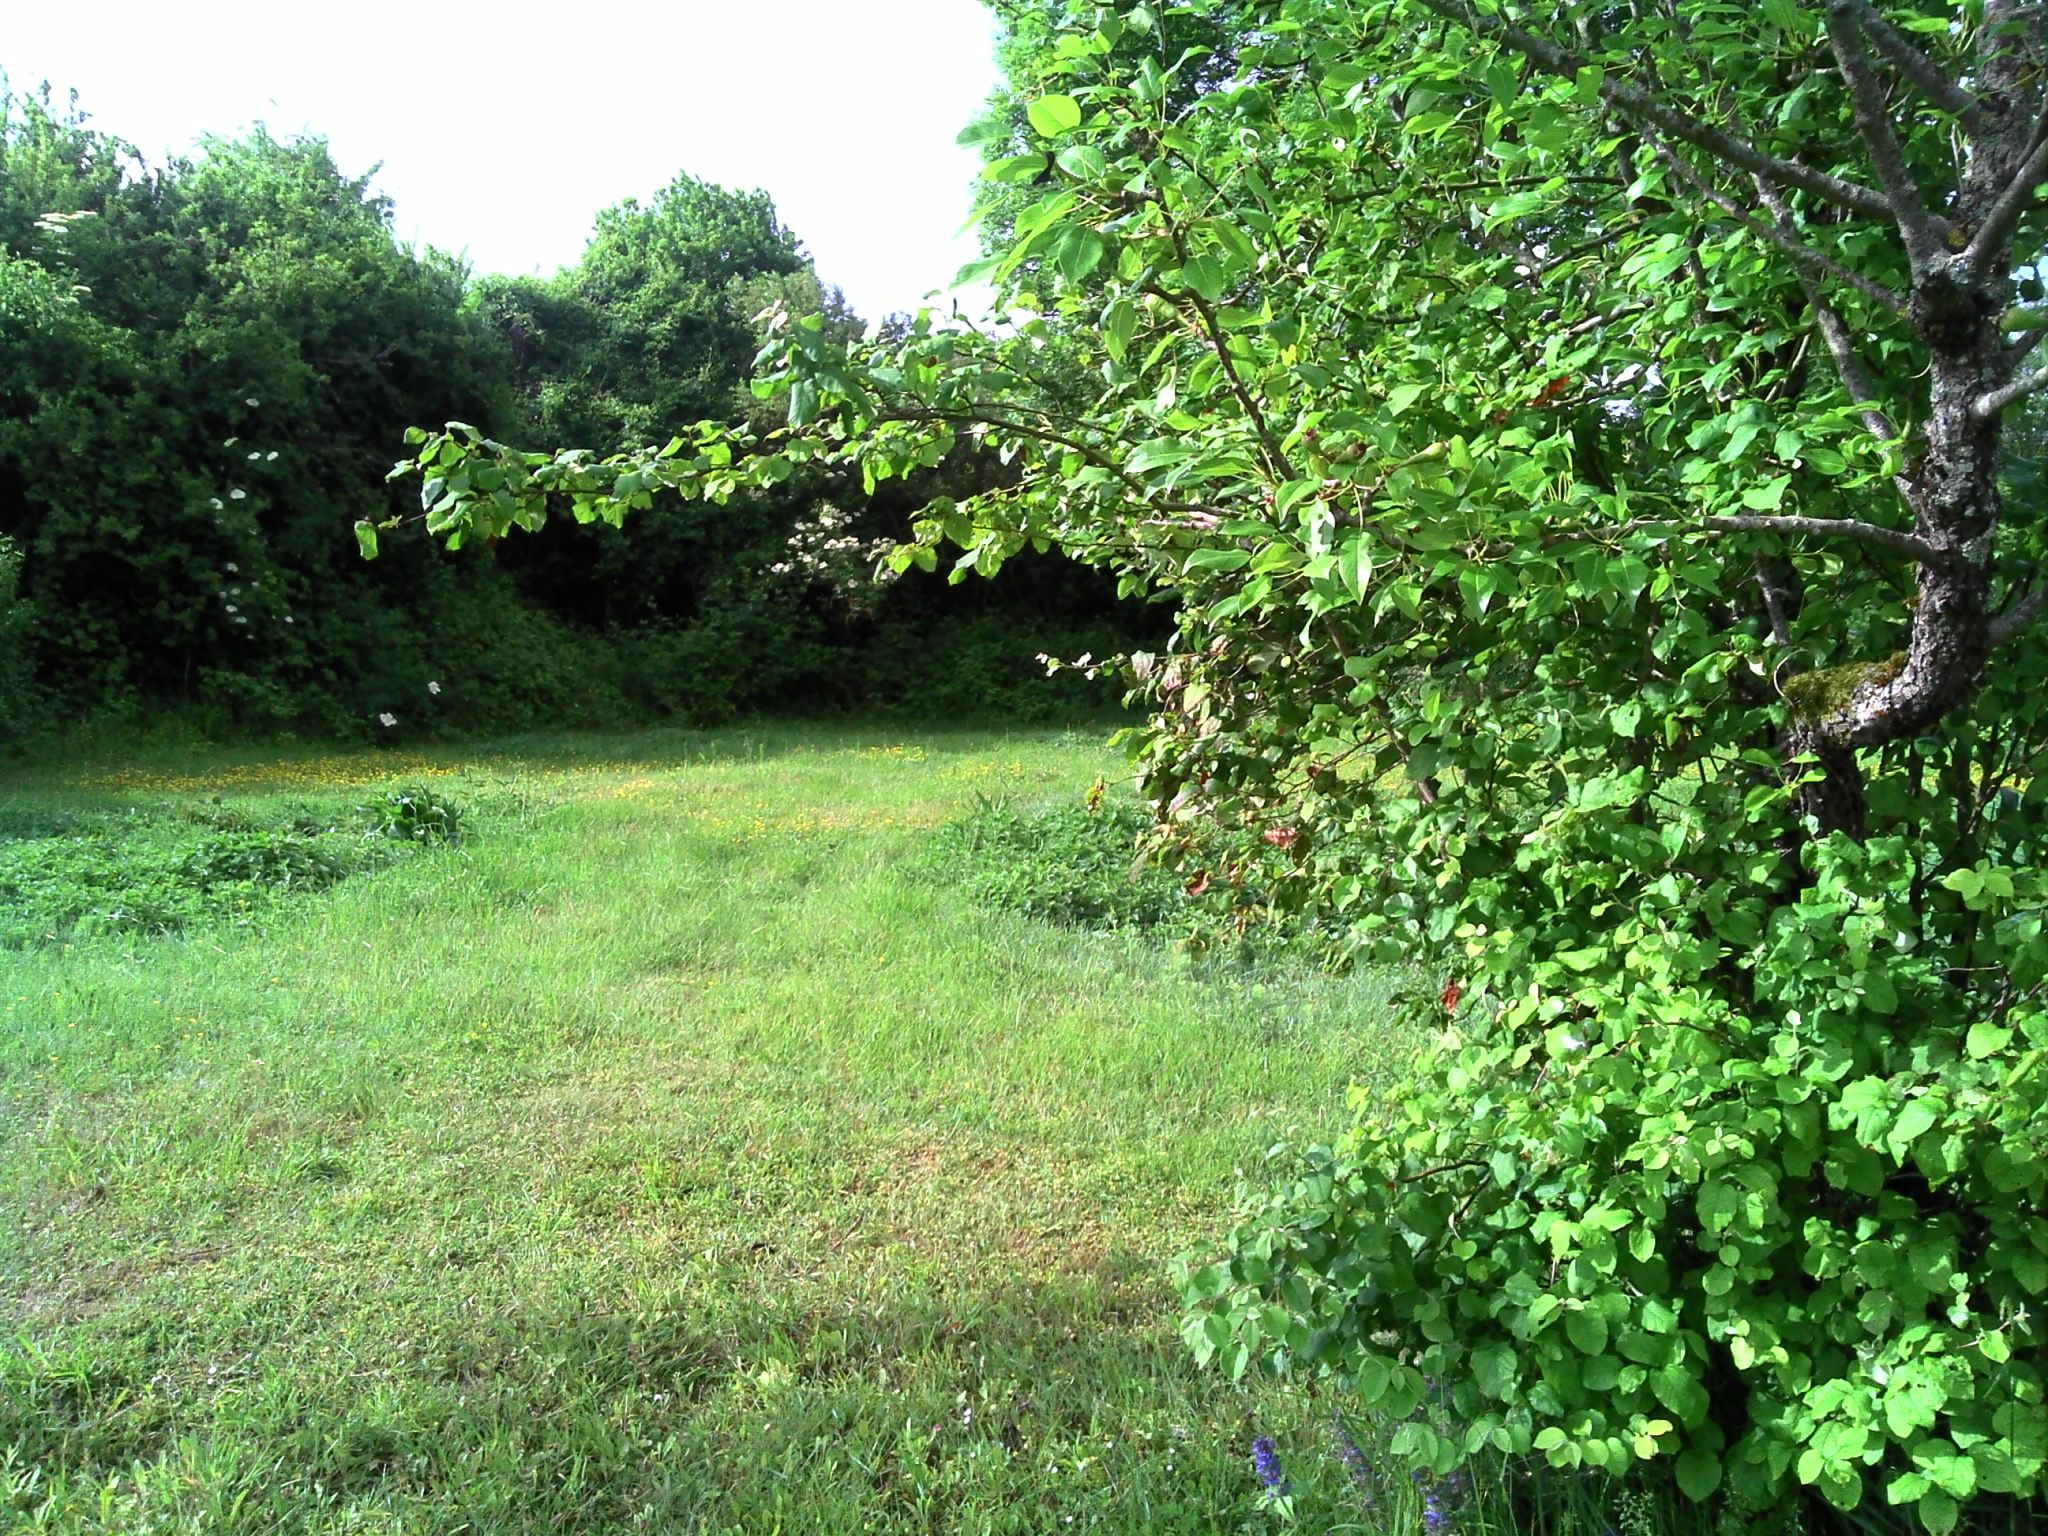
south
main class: Grassland
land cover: Grassland with sparse tree/shrub cover
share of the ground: > 75 %
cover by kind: herbaceous plants 90 %, broadleaved forest trees 5 %, shrubs 5 %
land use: Residential
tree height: < 5 m
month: June
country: FR
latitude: 47.9730
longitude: 1.3433
